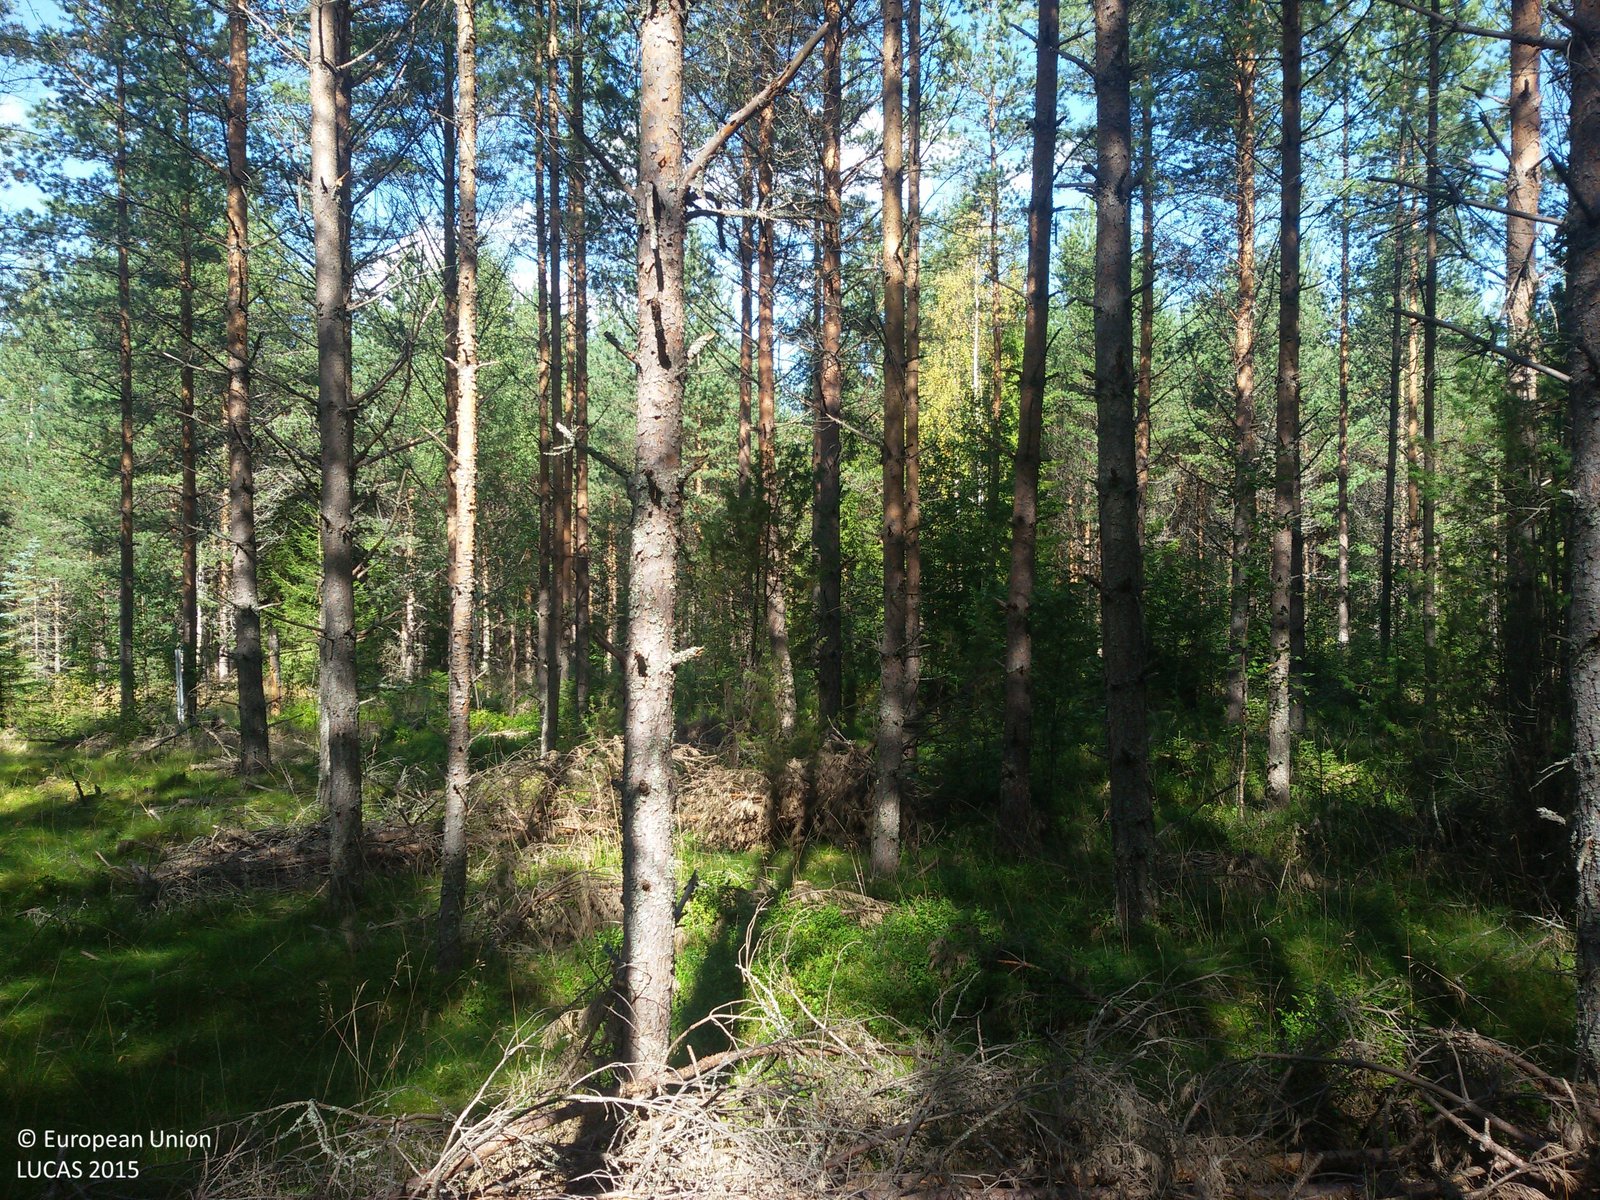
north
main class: Woodland
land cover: Pine dominated coniferous woodland
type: boreal forest
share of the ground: > 75 %
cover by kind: coniferous forest trees 80 %, herbaceous plants 15 %, lichens and mosses 5 %
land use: Forestry
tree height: > 5 m
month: August
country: SE
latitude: 60.6443
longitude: 15.6744
